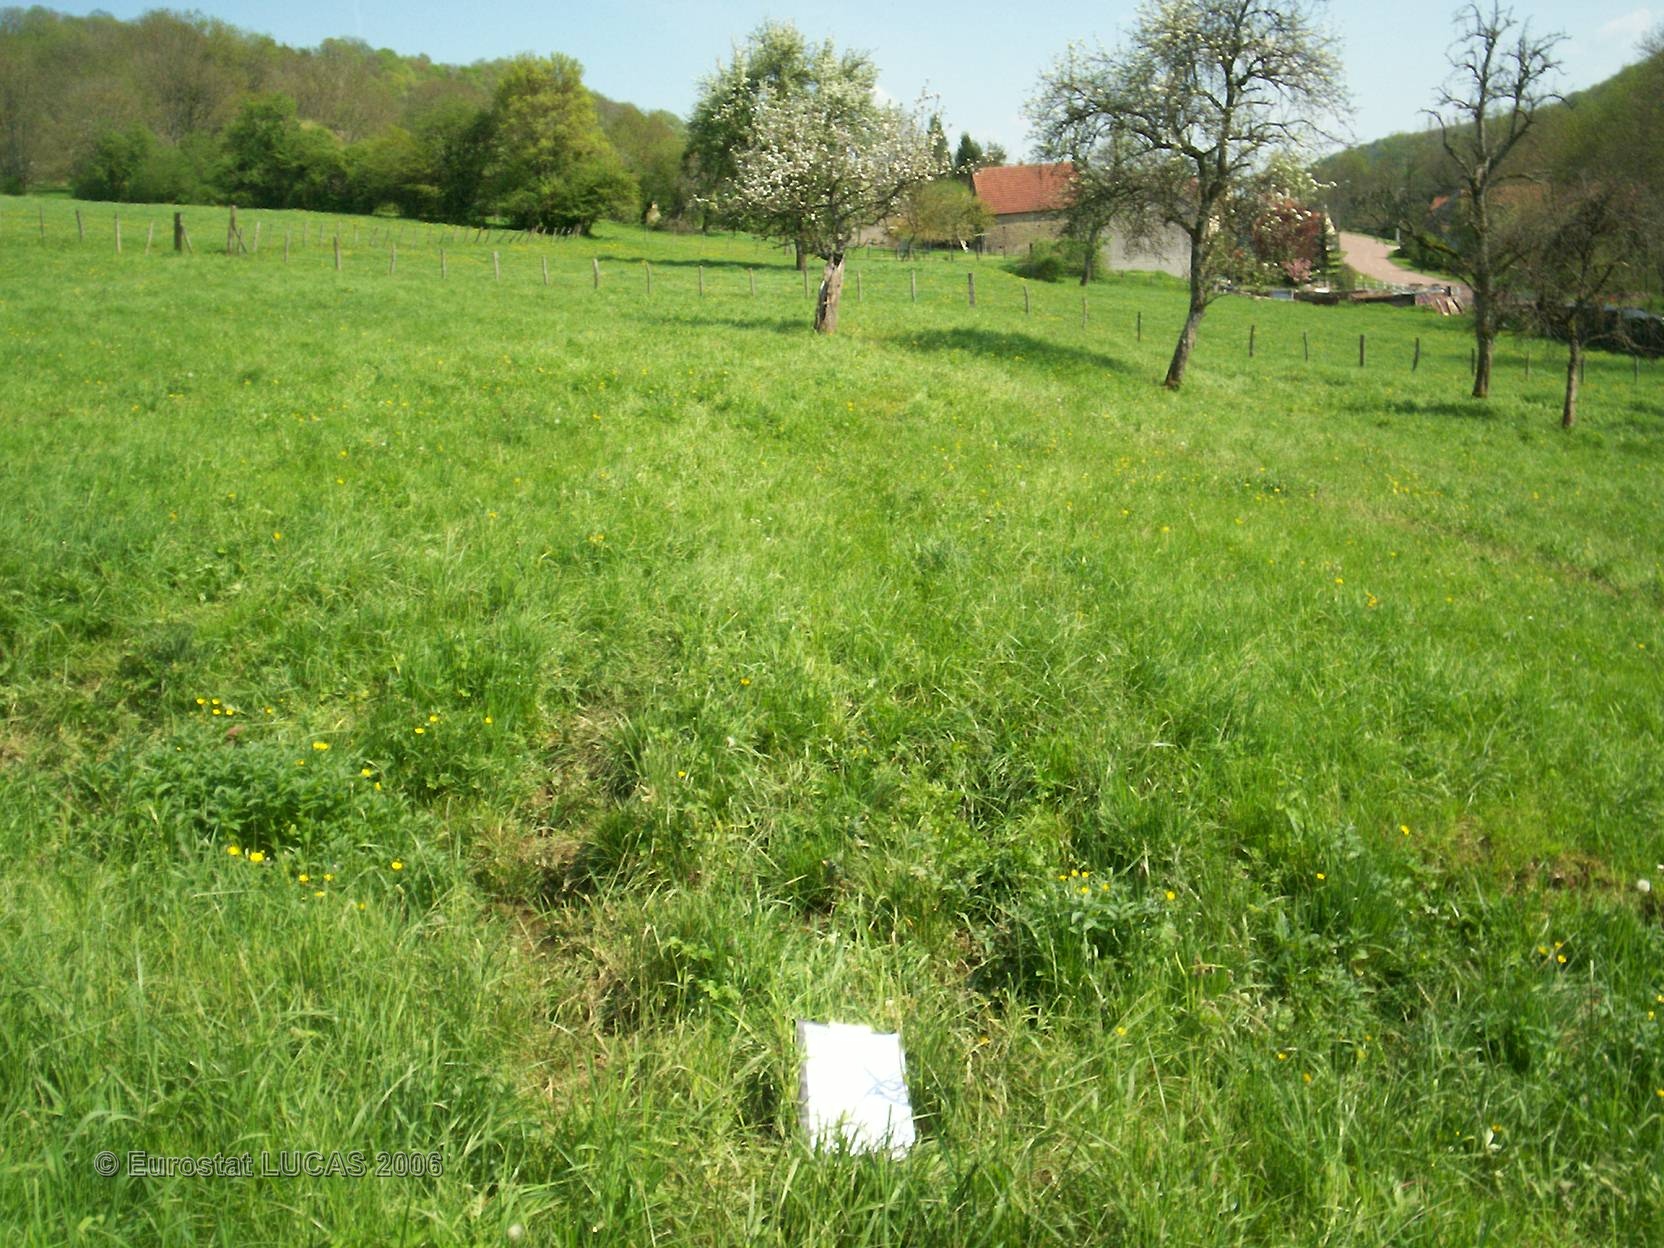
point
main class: Grassland
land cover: Grassland without tree/shrub cover
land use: Agriculture (excluding fallow land and kitchen gardens)
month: May
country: FR
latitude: 47.5331
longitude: 4.6195
